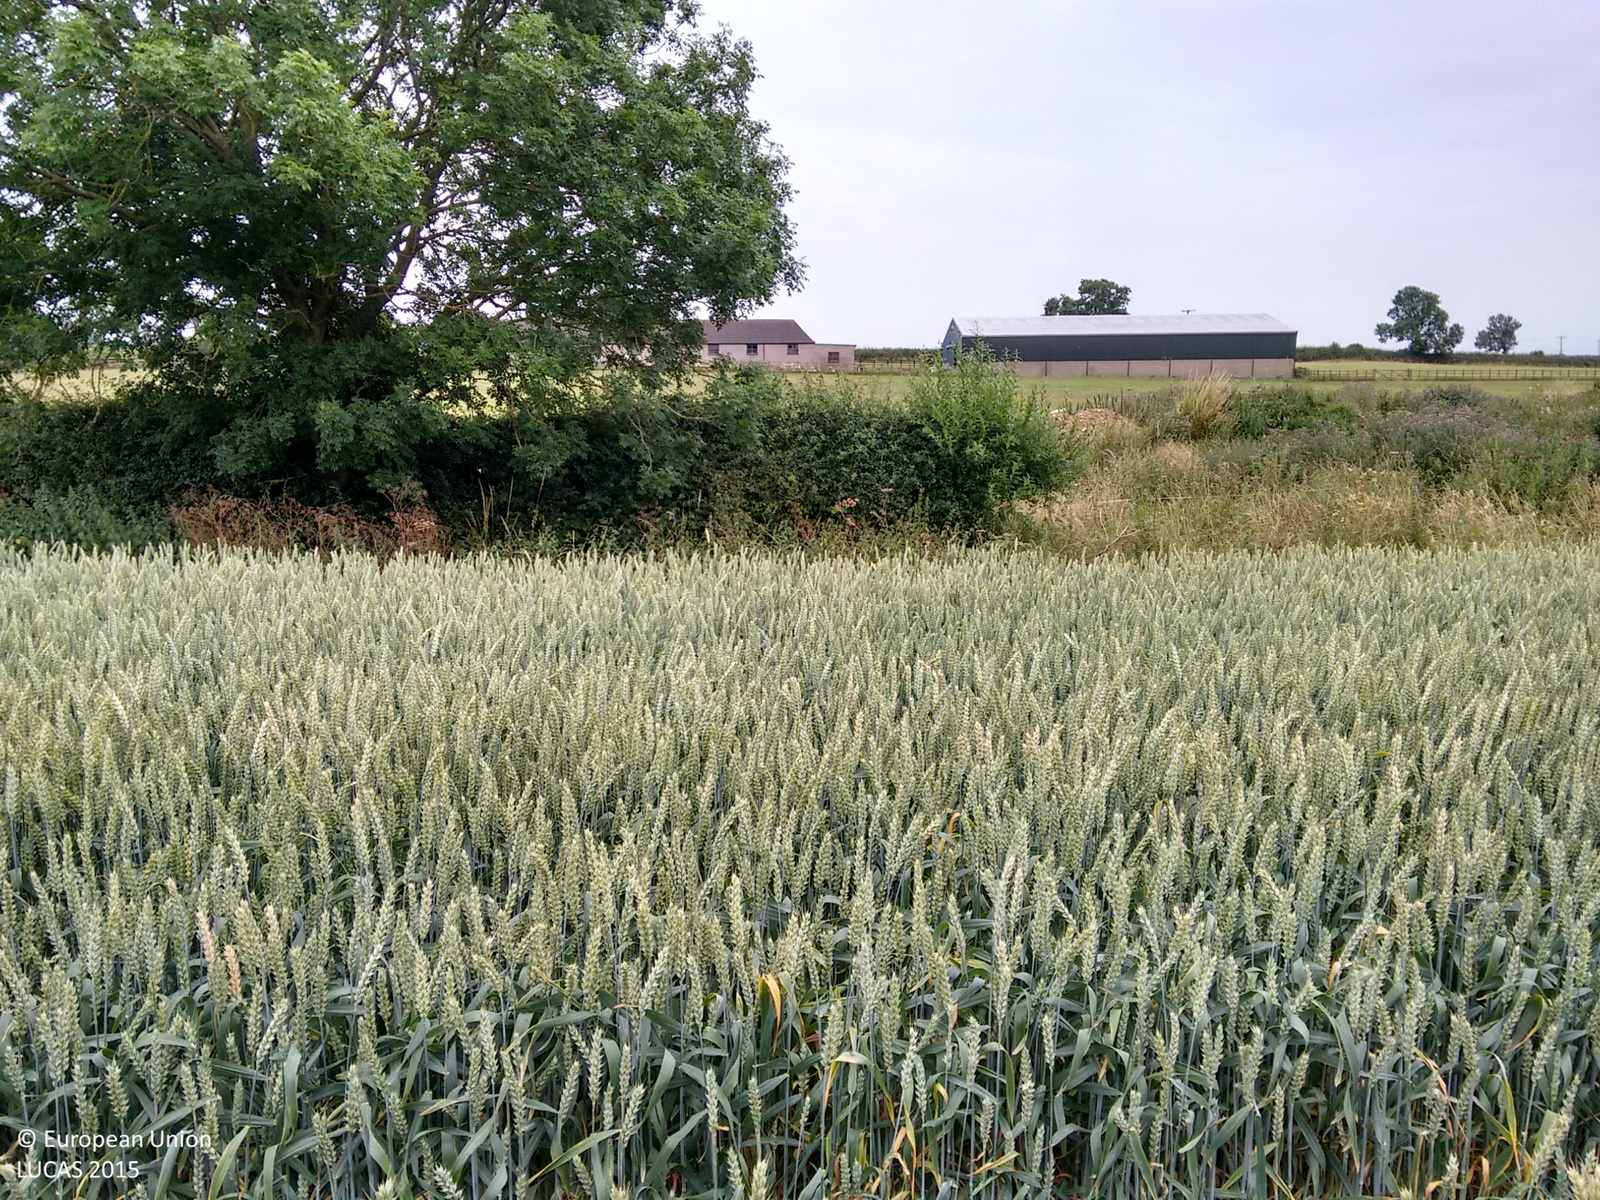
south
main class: Cropland
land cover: Common wheat
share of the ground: > 75 %
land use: Agriculture (excluding fallow land and kitchen gardens)
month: July
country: GB
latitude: 52.7395
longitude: -0.9596
